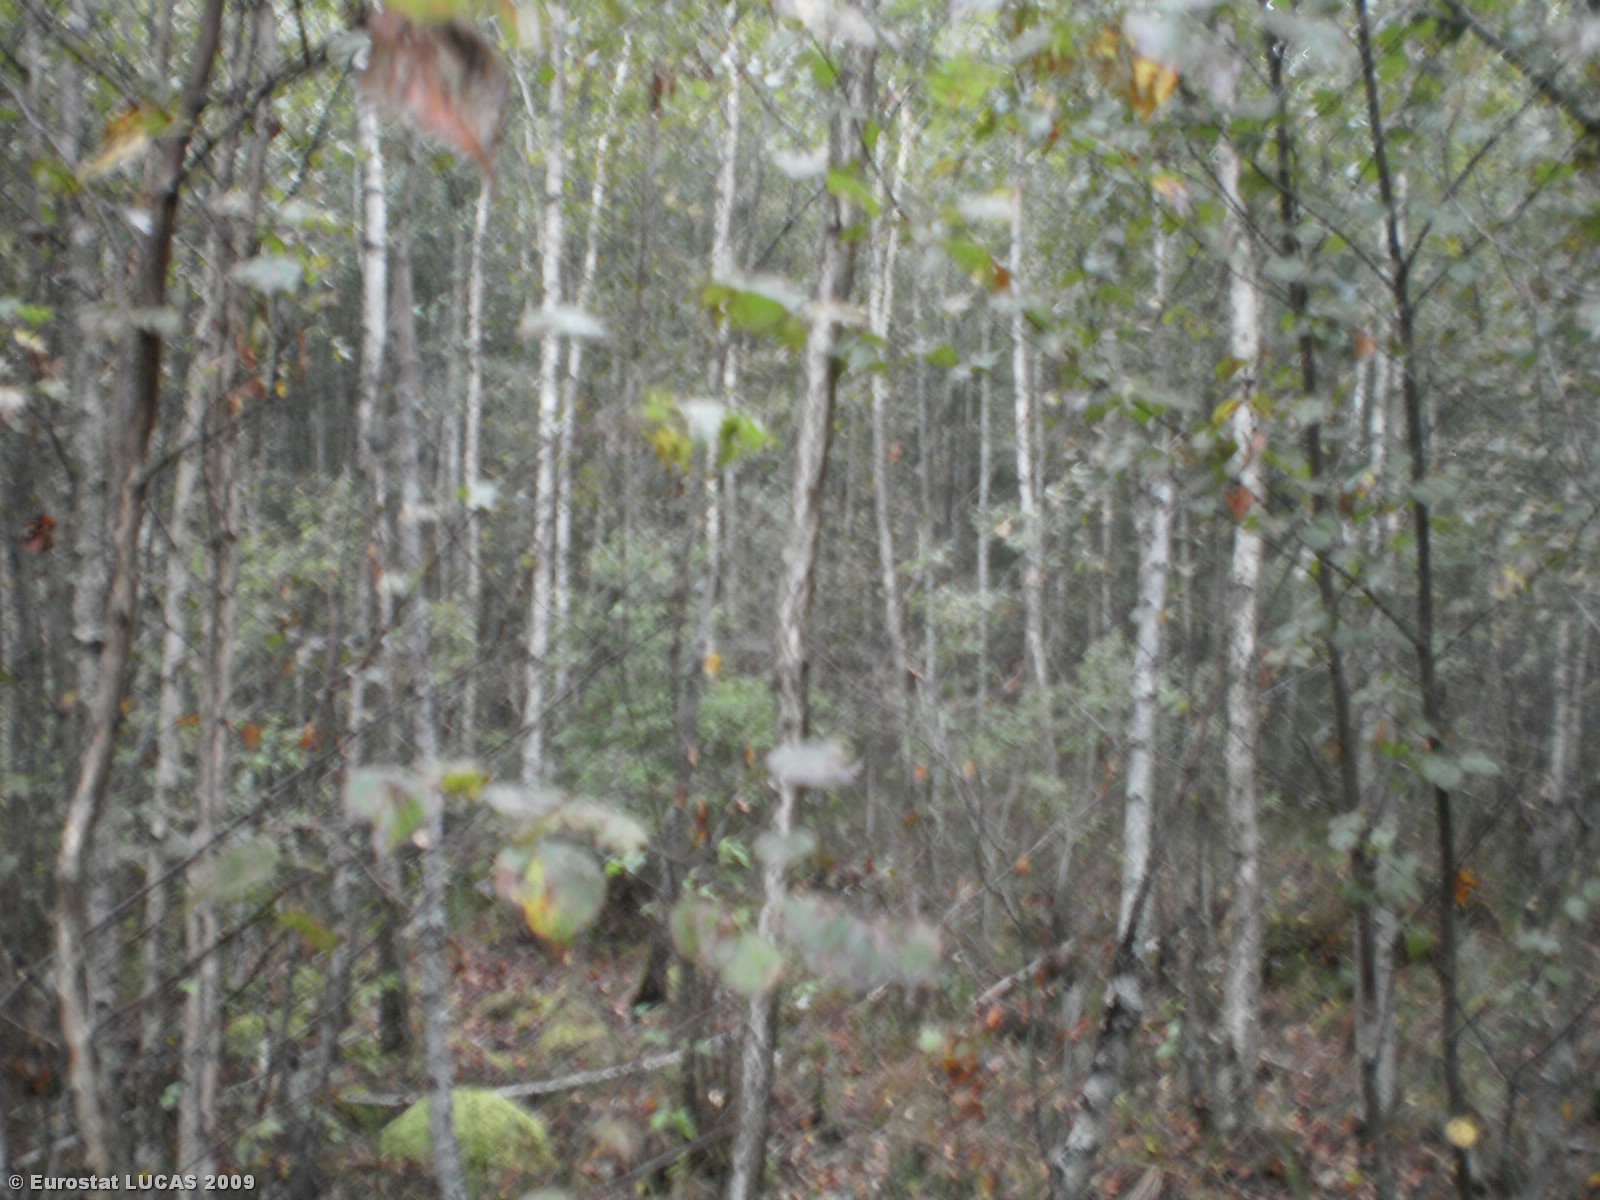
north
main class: Woodland
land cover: Broadleaved woodland
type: mire and swamp forests
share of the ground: > 75 %
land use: Forestry
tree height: > 5 m
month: August
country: LT
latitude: 55.3670
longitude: 25.6378
